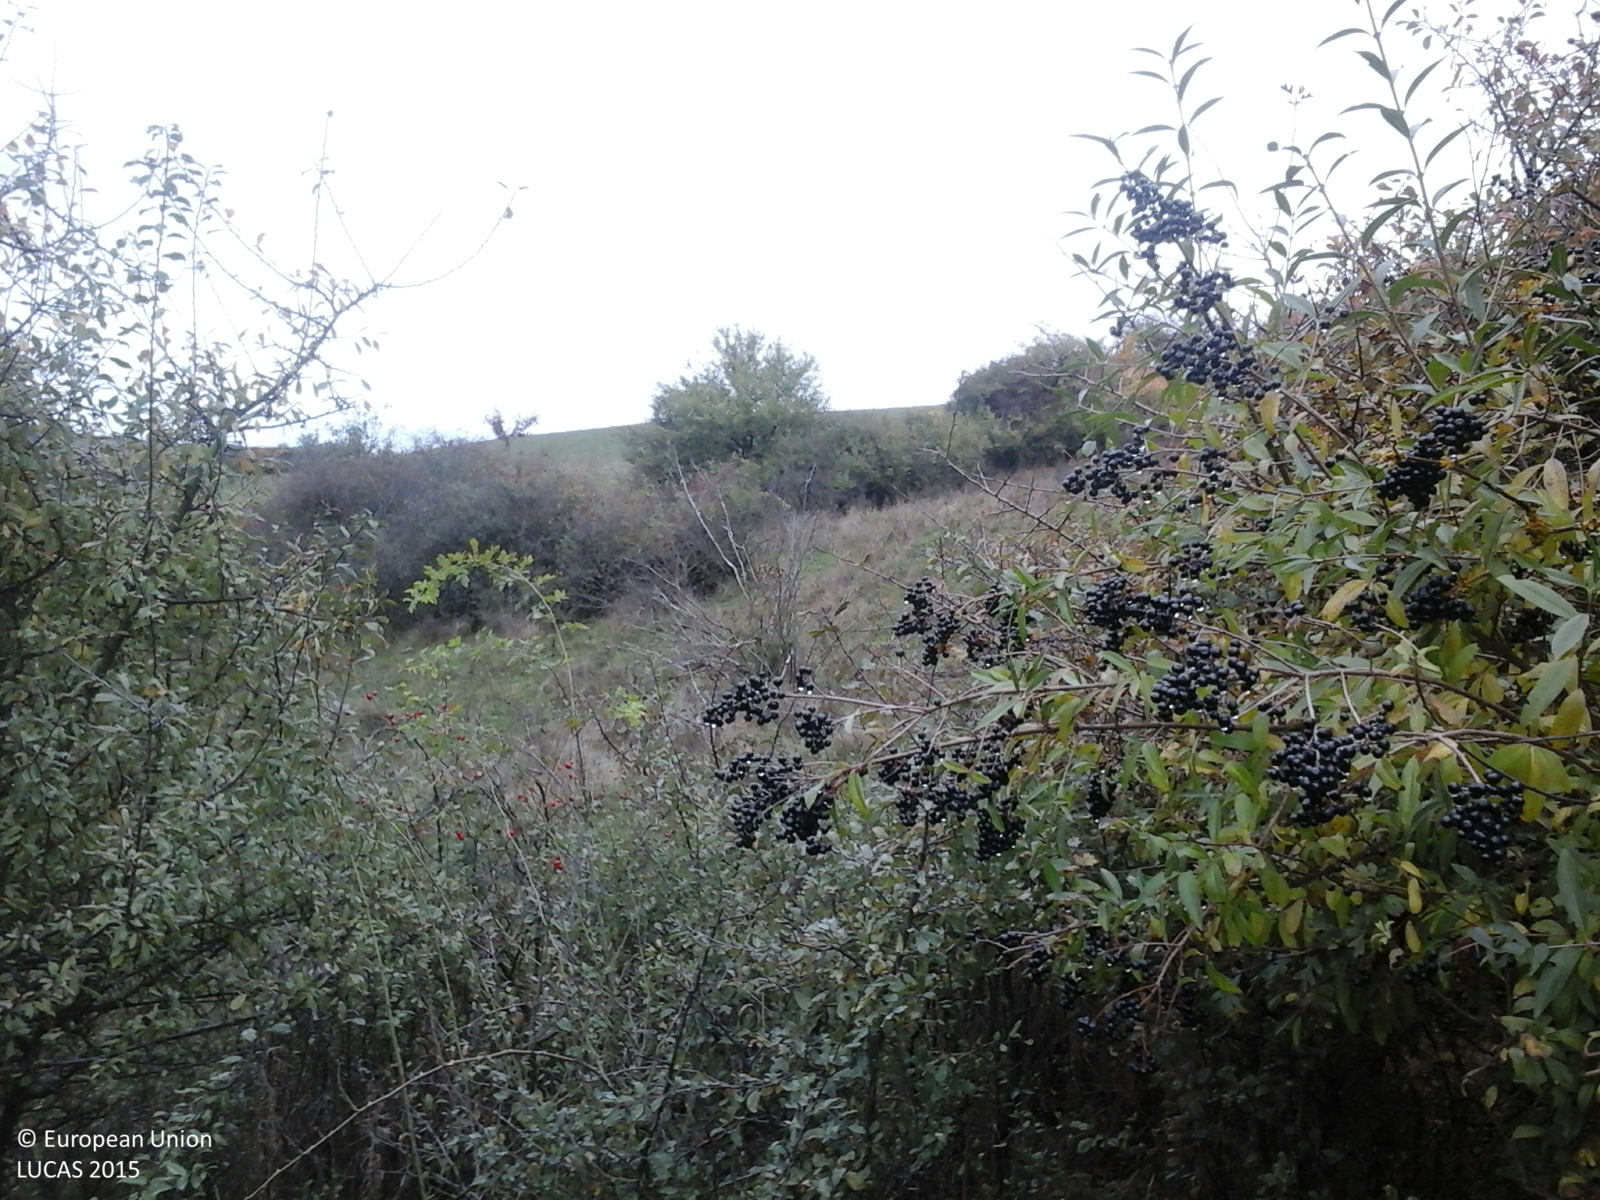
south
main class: Shrubland
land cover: Shrubland without tree cover
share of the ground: > 75 %
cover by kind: herbaceous plants 90 %, shrubs 10 %
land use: Semi-natural and natural areas not in use
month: October
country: RO
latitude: 45.8646
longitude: 24.1282
